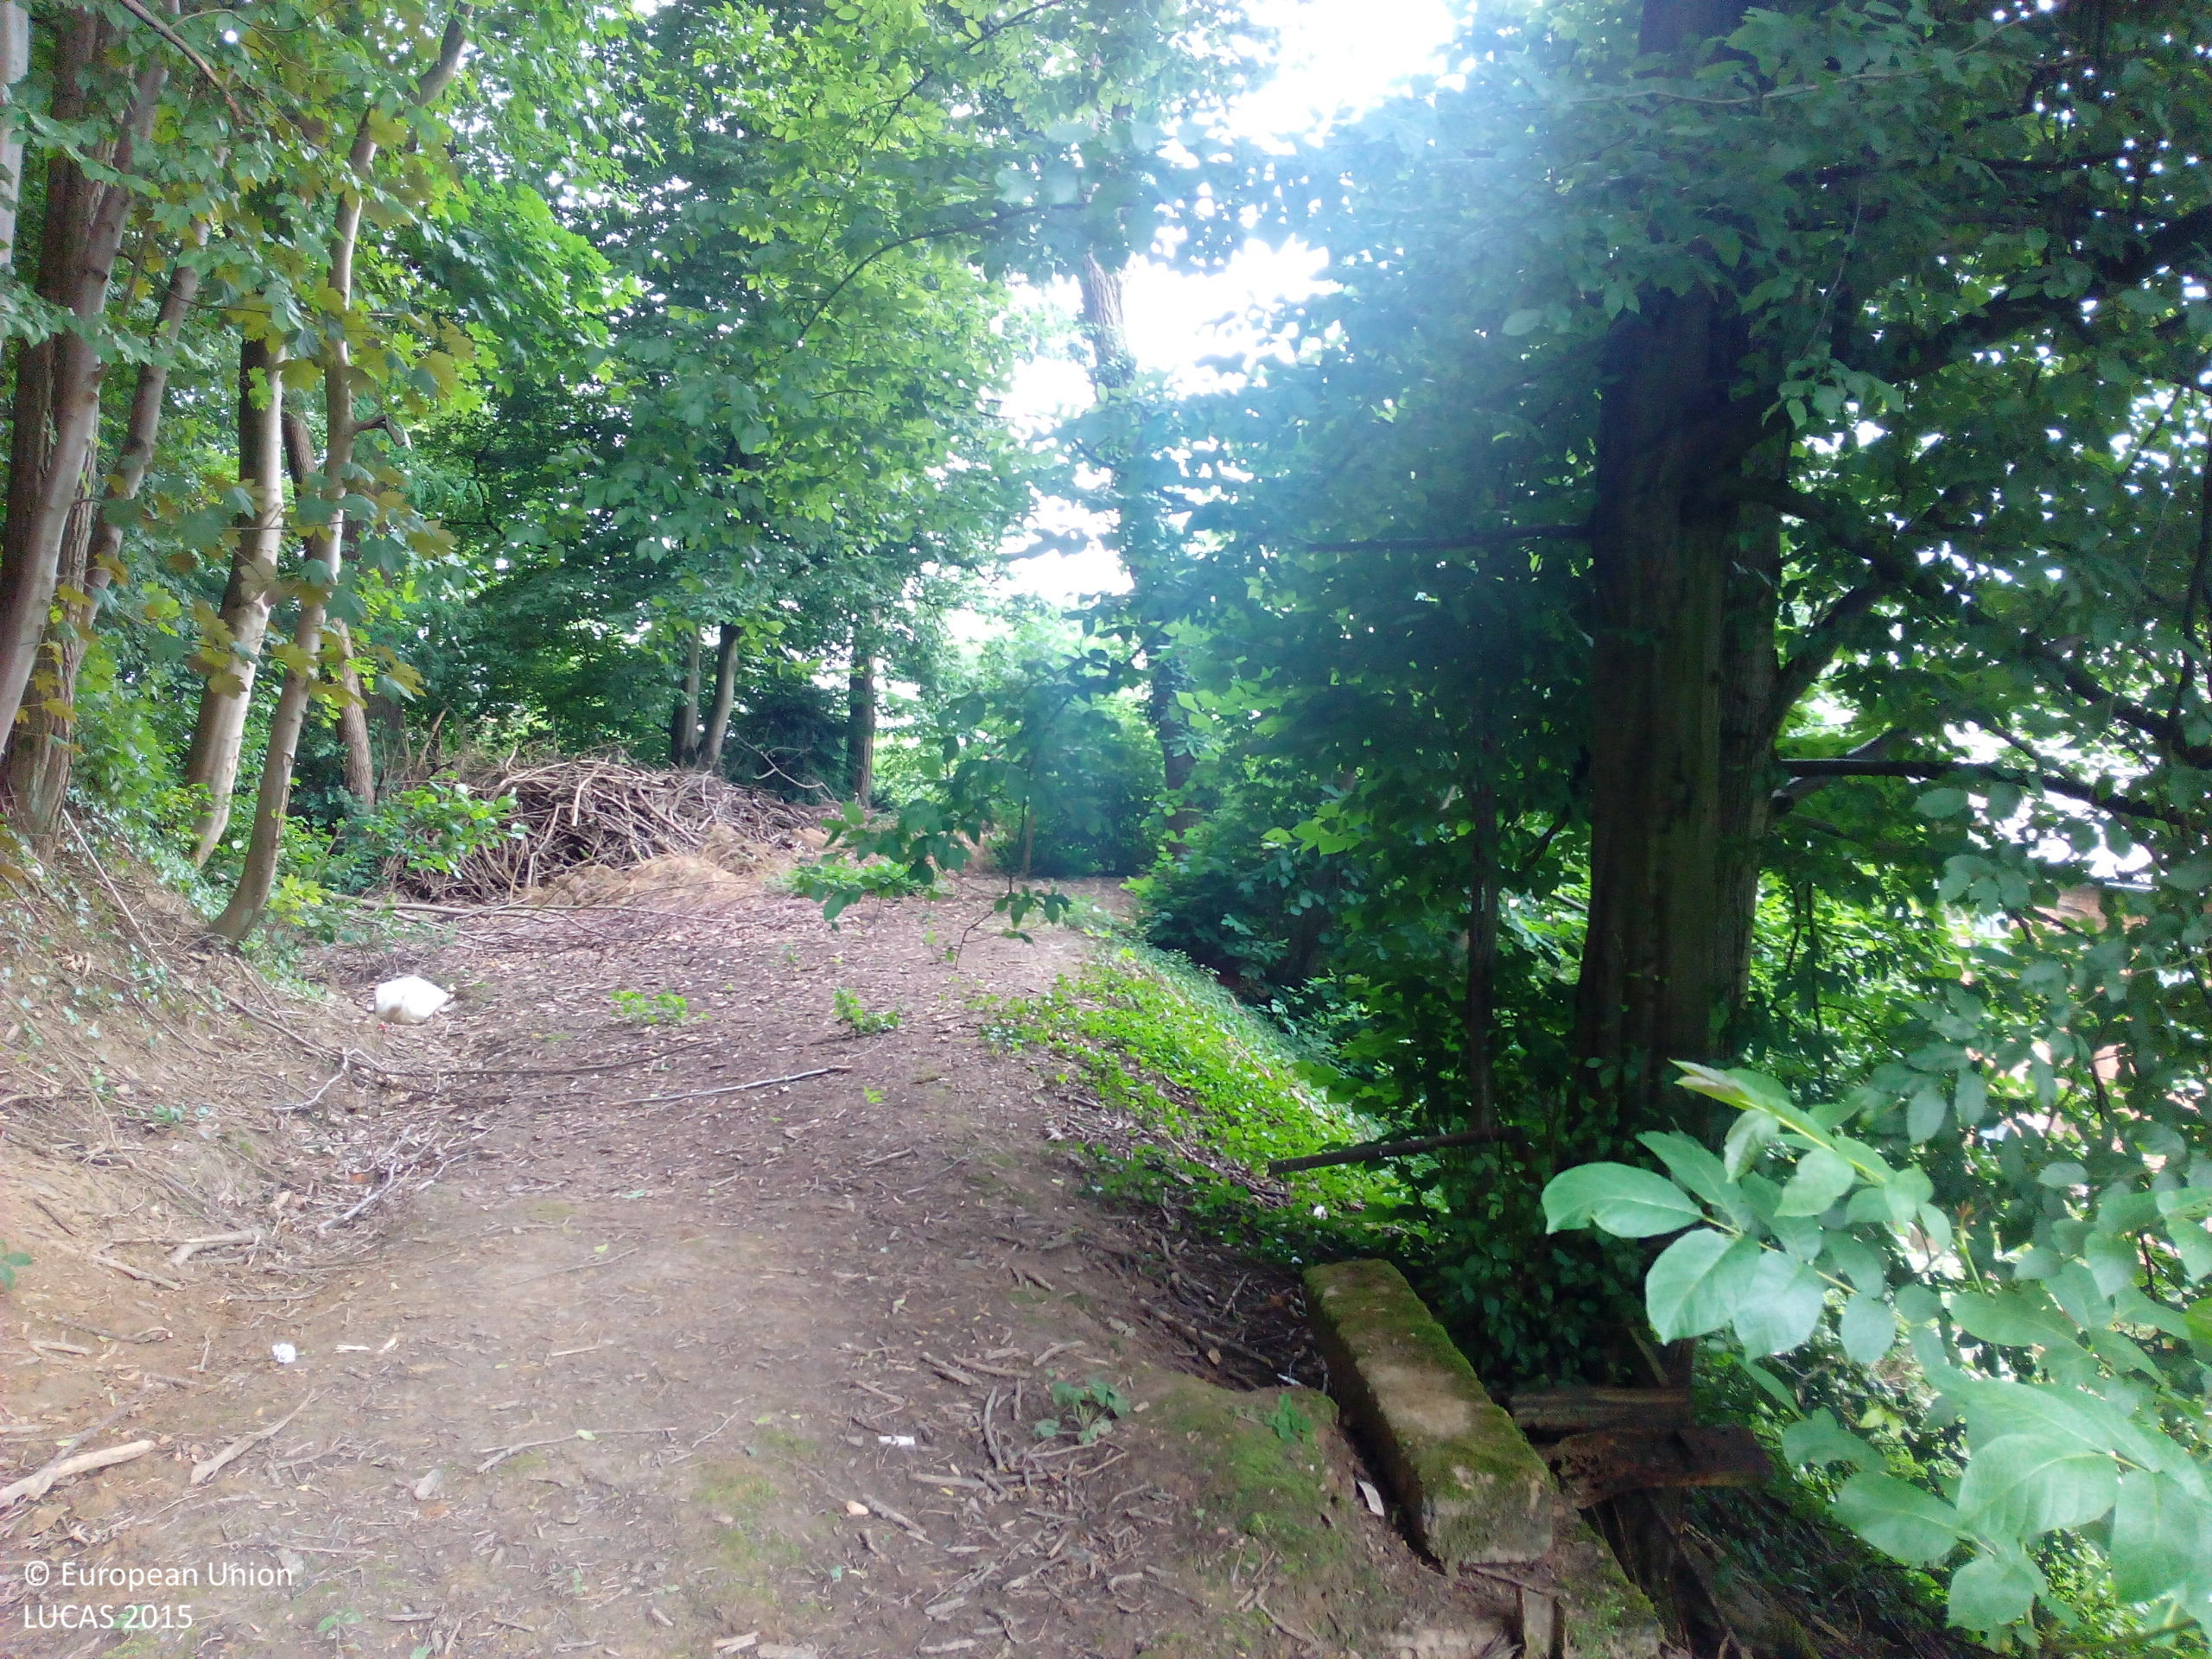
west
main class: Woodland
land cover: Broadleaved woodland
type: mesophytic deciduous forest
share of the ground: > 75 %
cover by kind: broadleaved forest trees 80 %, herbaceous plants 10 %, shrubs 5 %, consolidated bare surface 5 %
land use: Abandoned areas
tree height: > 5 m
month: June
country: DE
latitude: 48.6209
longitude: 8.0880
